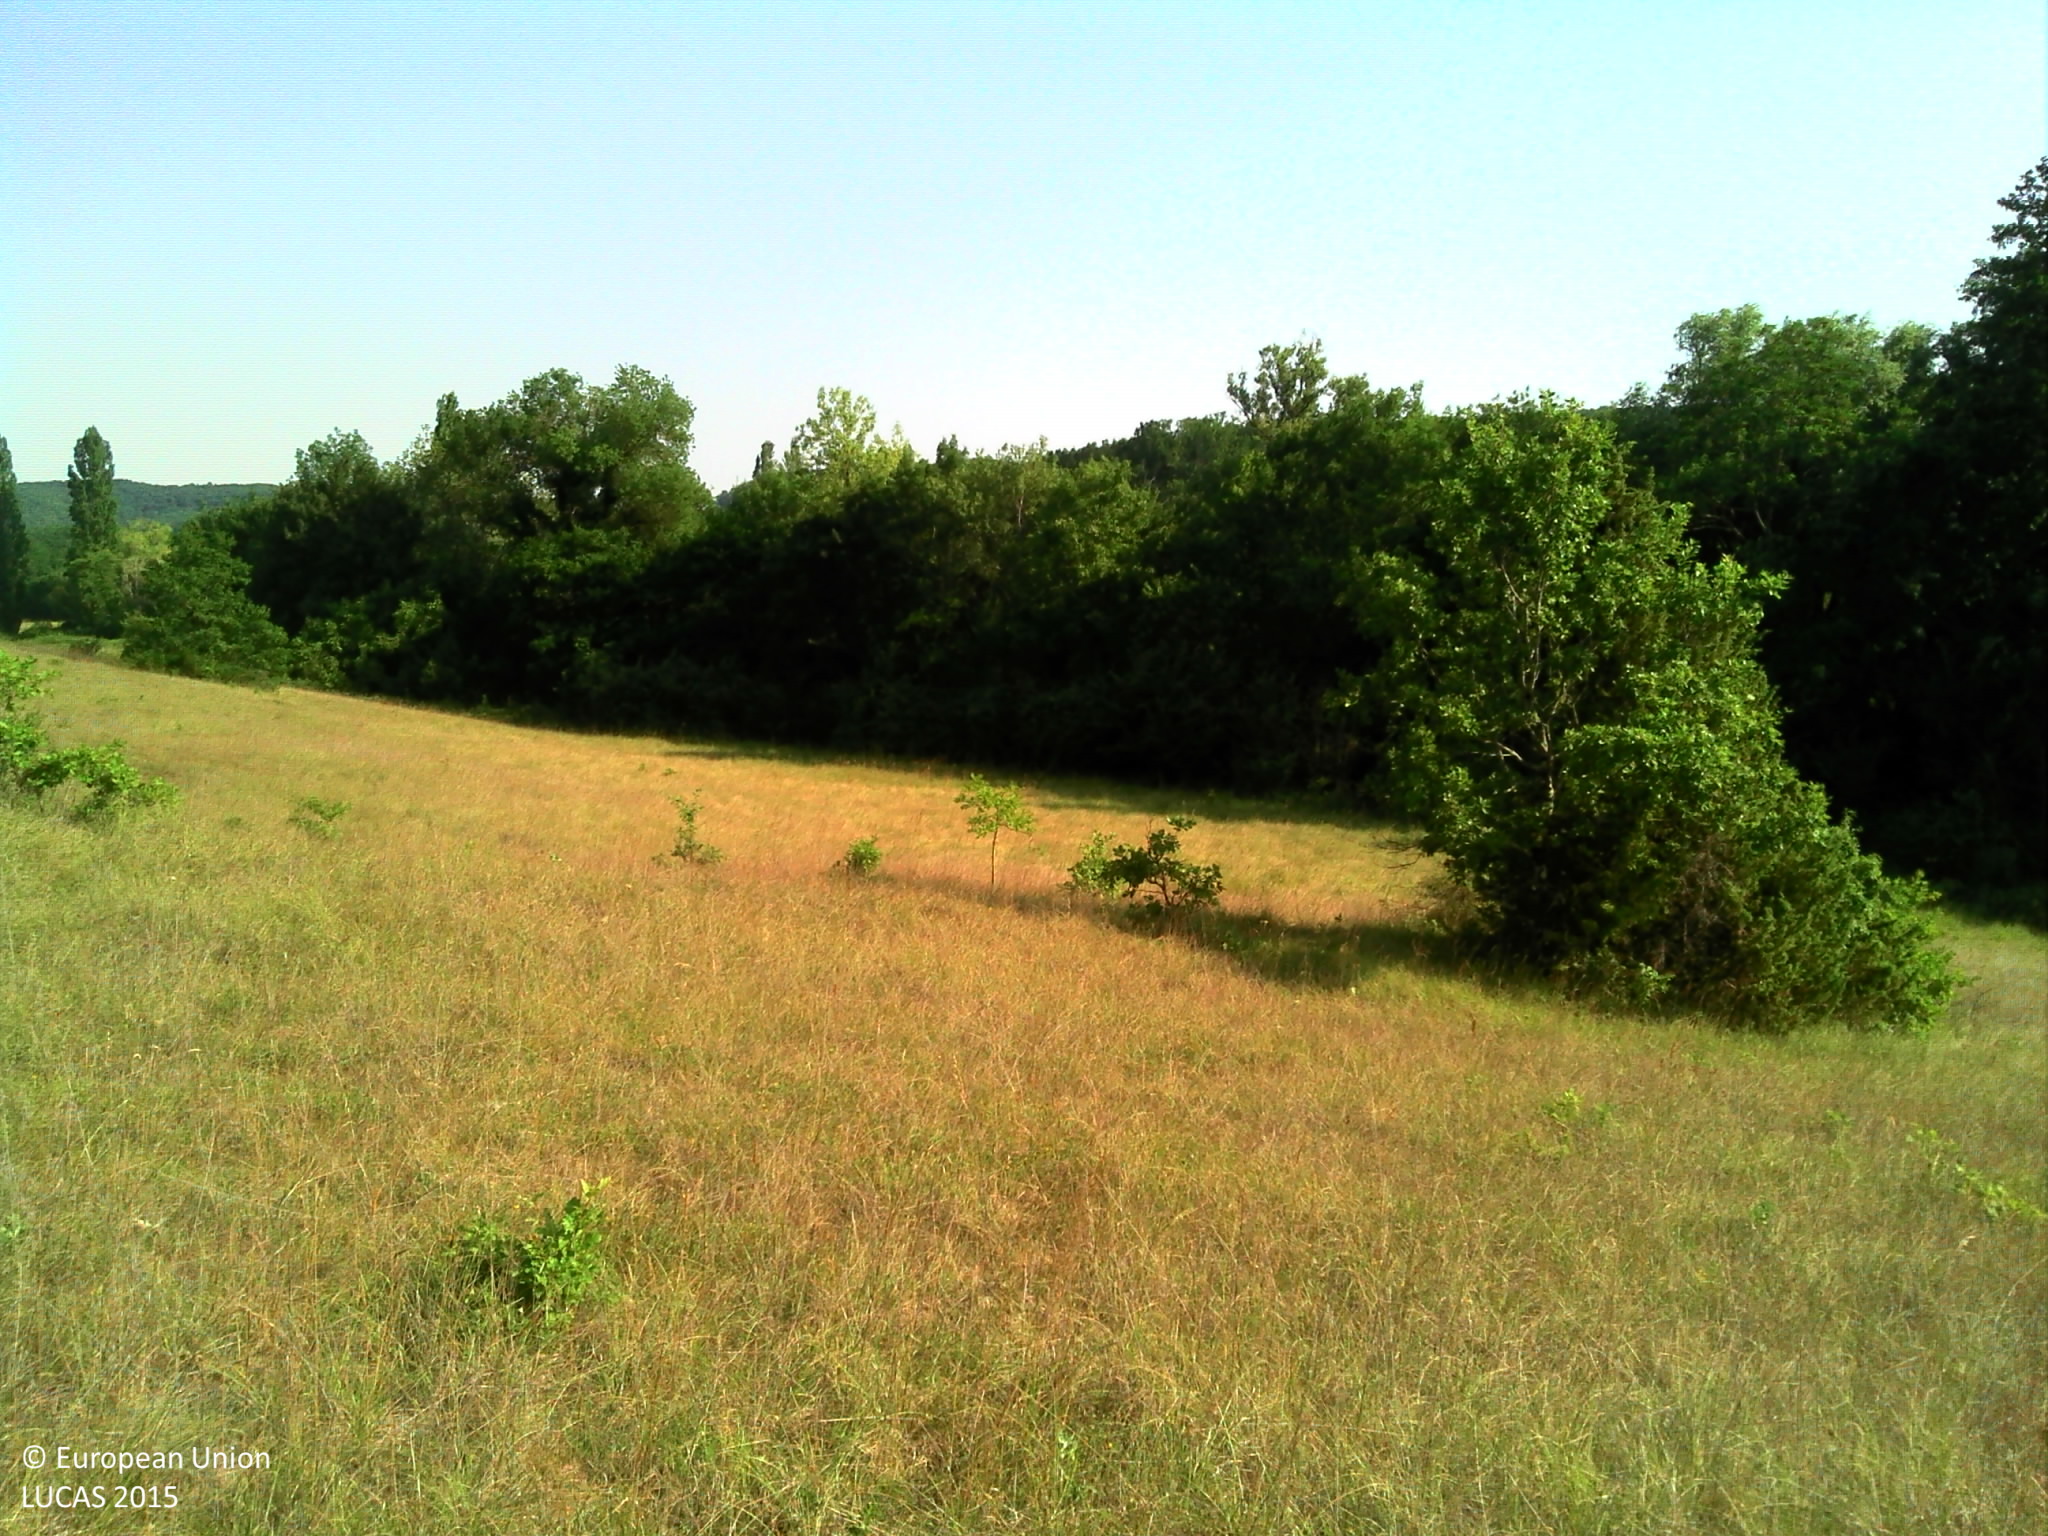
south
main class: Grassland
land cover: Grassland with sparse tree/shrub cover
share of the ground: > 75 %
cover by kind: herbaceous plants 90 %, broadleaved forest trees 5 %, shrubs 5 %
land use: Agriculture (excluding fallow land and kitchen gardens)
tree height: < 5 m
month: July
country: FR
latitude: 44.4229
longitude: 0.9141
